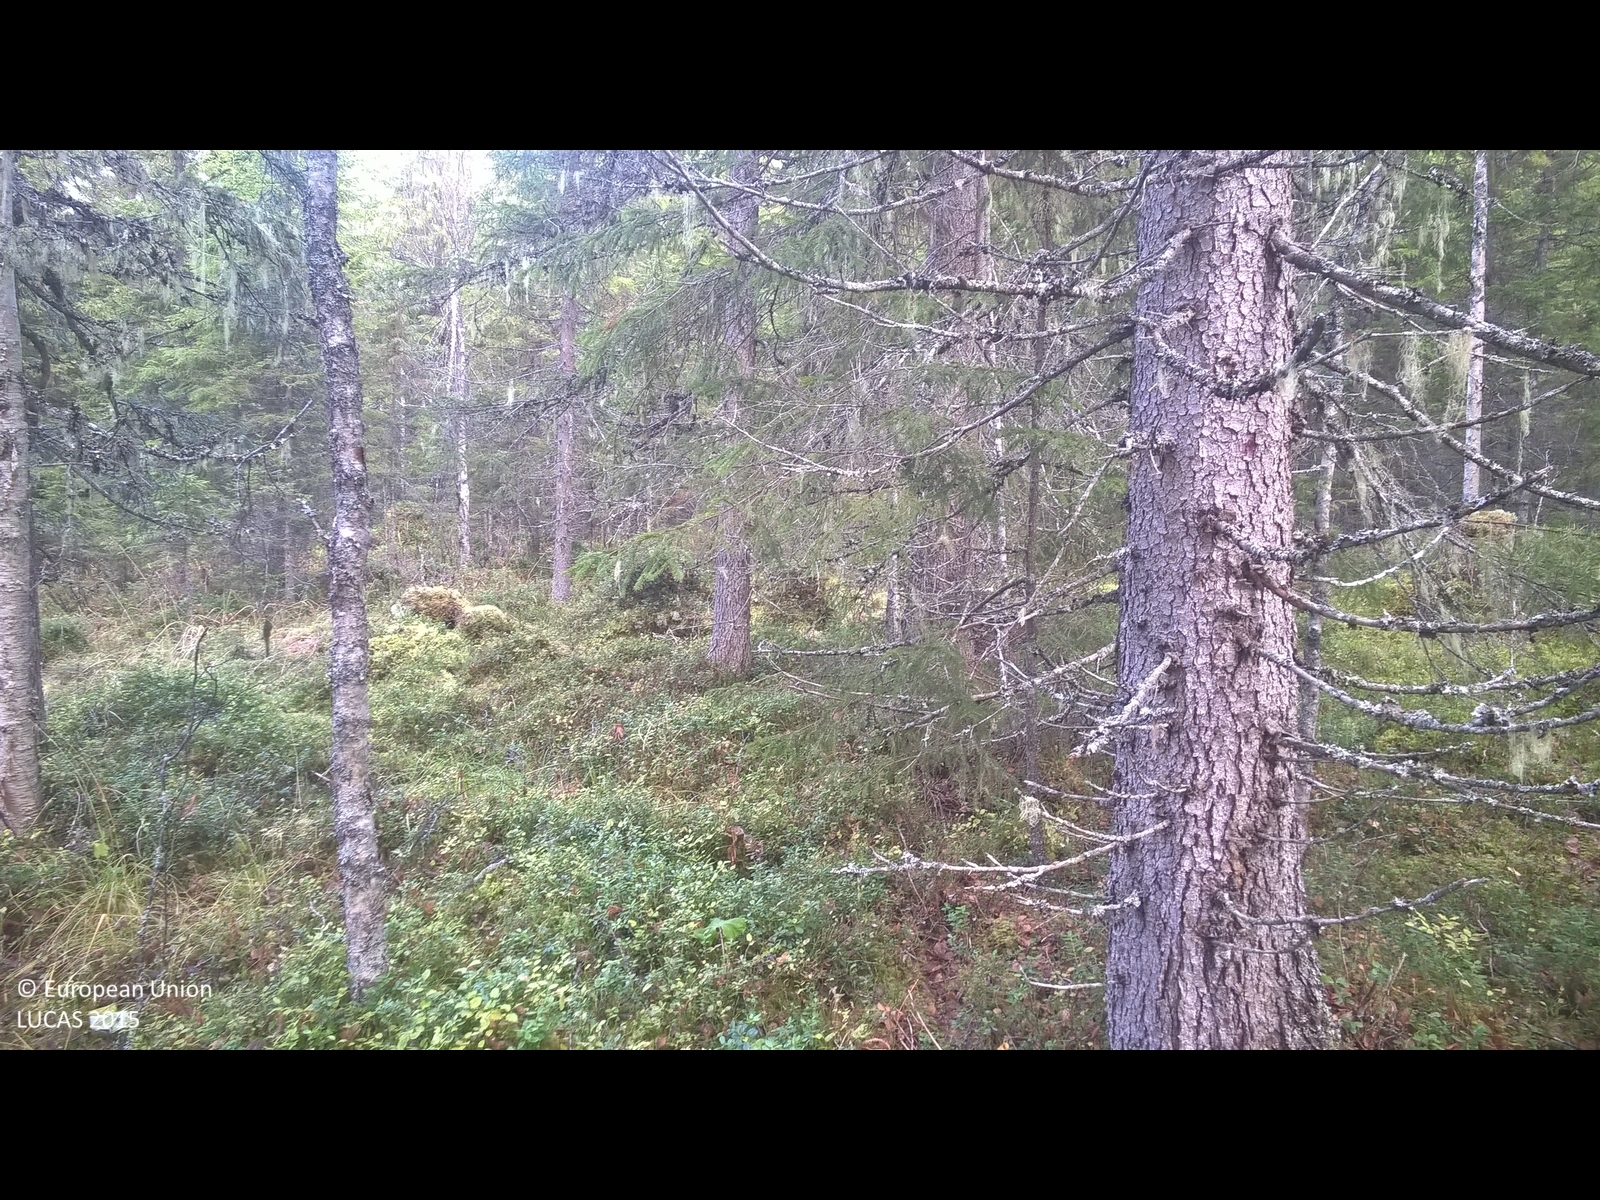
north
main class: Woodland
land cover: Spruce dominated coniferous woodland
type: boreal forest
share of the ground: 50 - 75 %
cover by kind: coniferous forest trees 60 %, lichens and mosses 30 %, broadleaved forest trees 10 %
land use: Forestry
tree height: > 5 m
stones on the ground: < 10 %
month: October
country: SE
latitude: 63.3388
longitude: 13.8759
